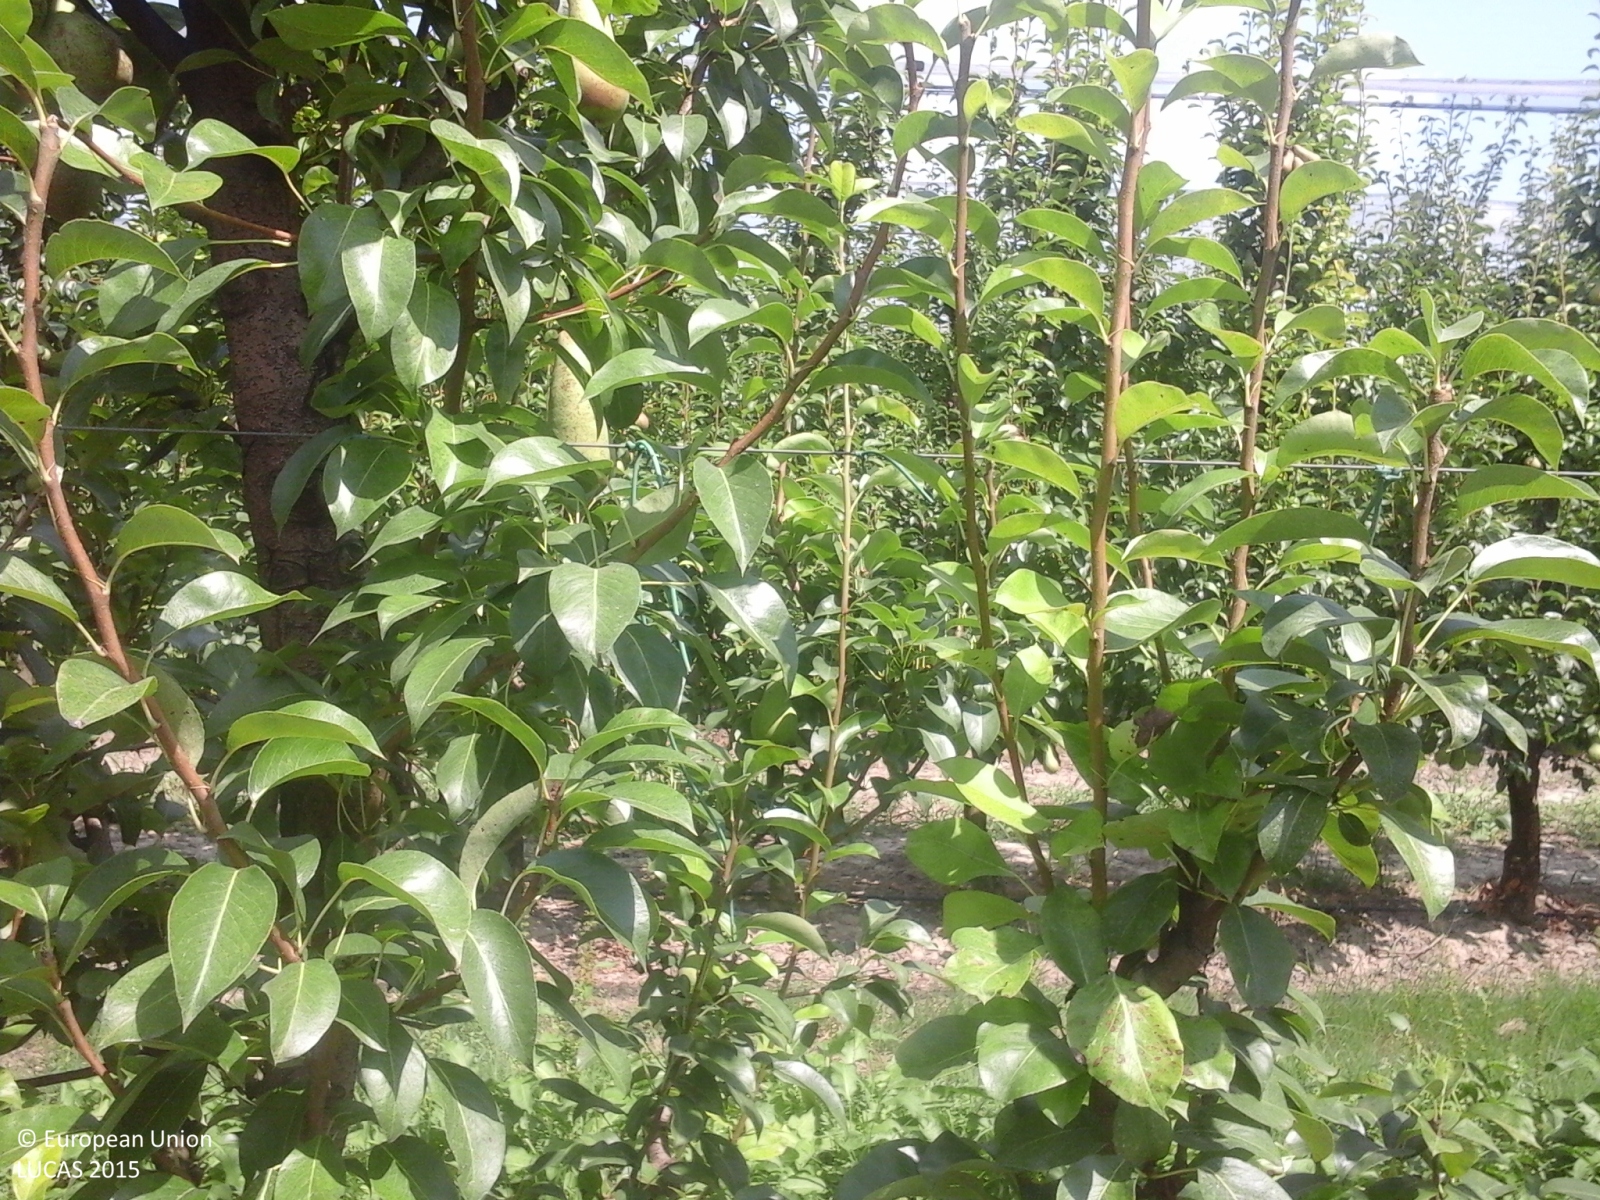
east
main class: Cropland
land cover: Pear fruit
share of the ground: > 75 %
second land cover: Grassland without tree/shrub cover
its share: > 75 %
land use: Agriculture (excluding fallow land and kitchen gardens)
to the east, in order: Pear fruit; Grassland without tree/shrub cover; Soya; Artificial constructions in urban areas
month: June
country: IT
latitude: 44.8858
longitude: 11.0993
